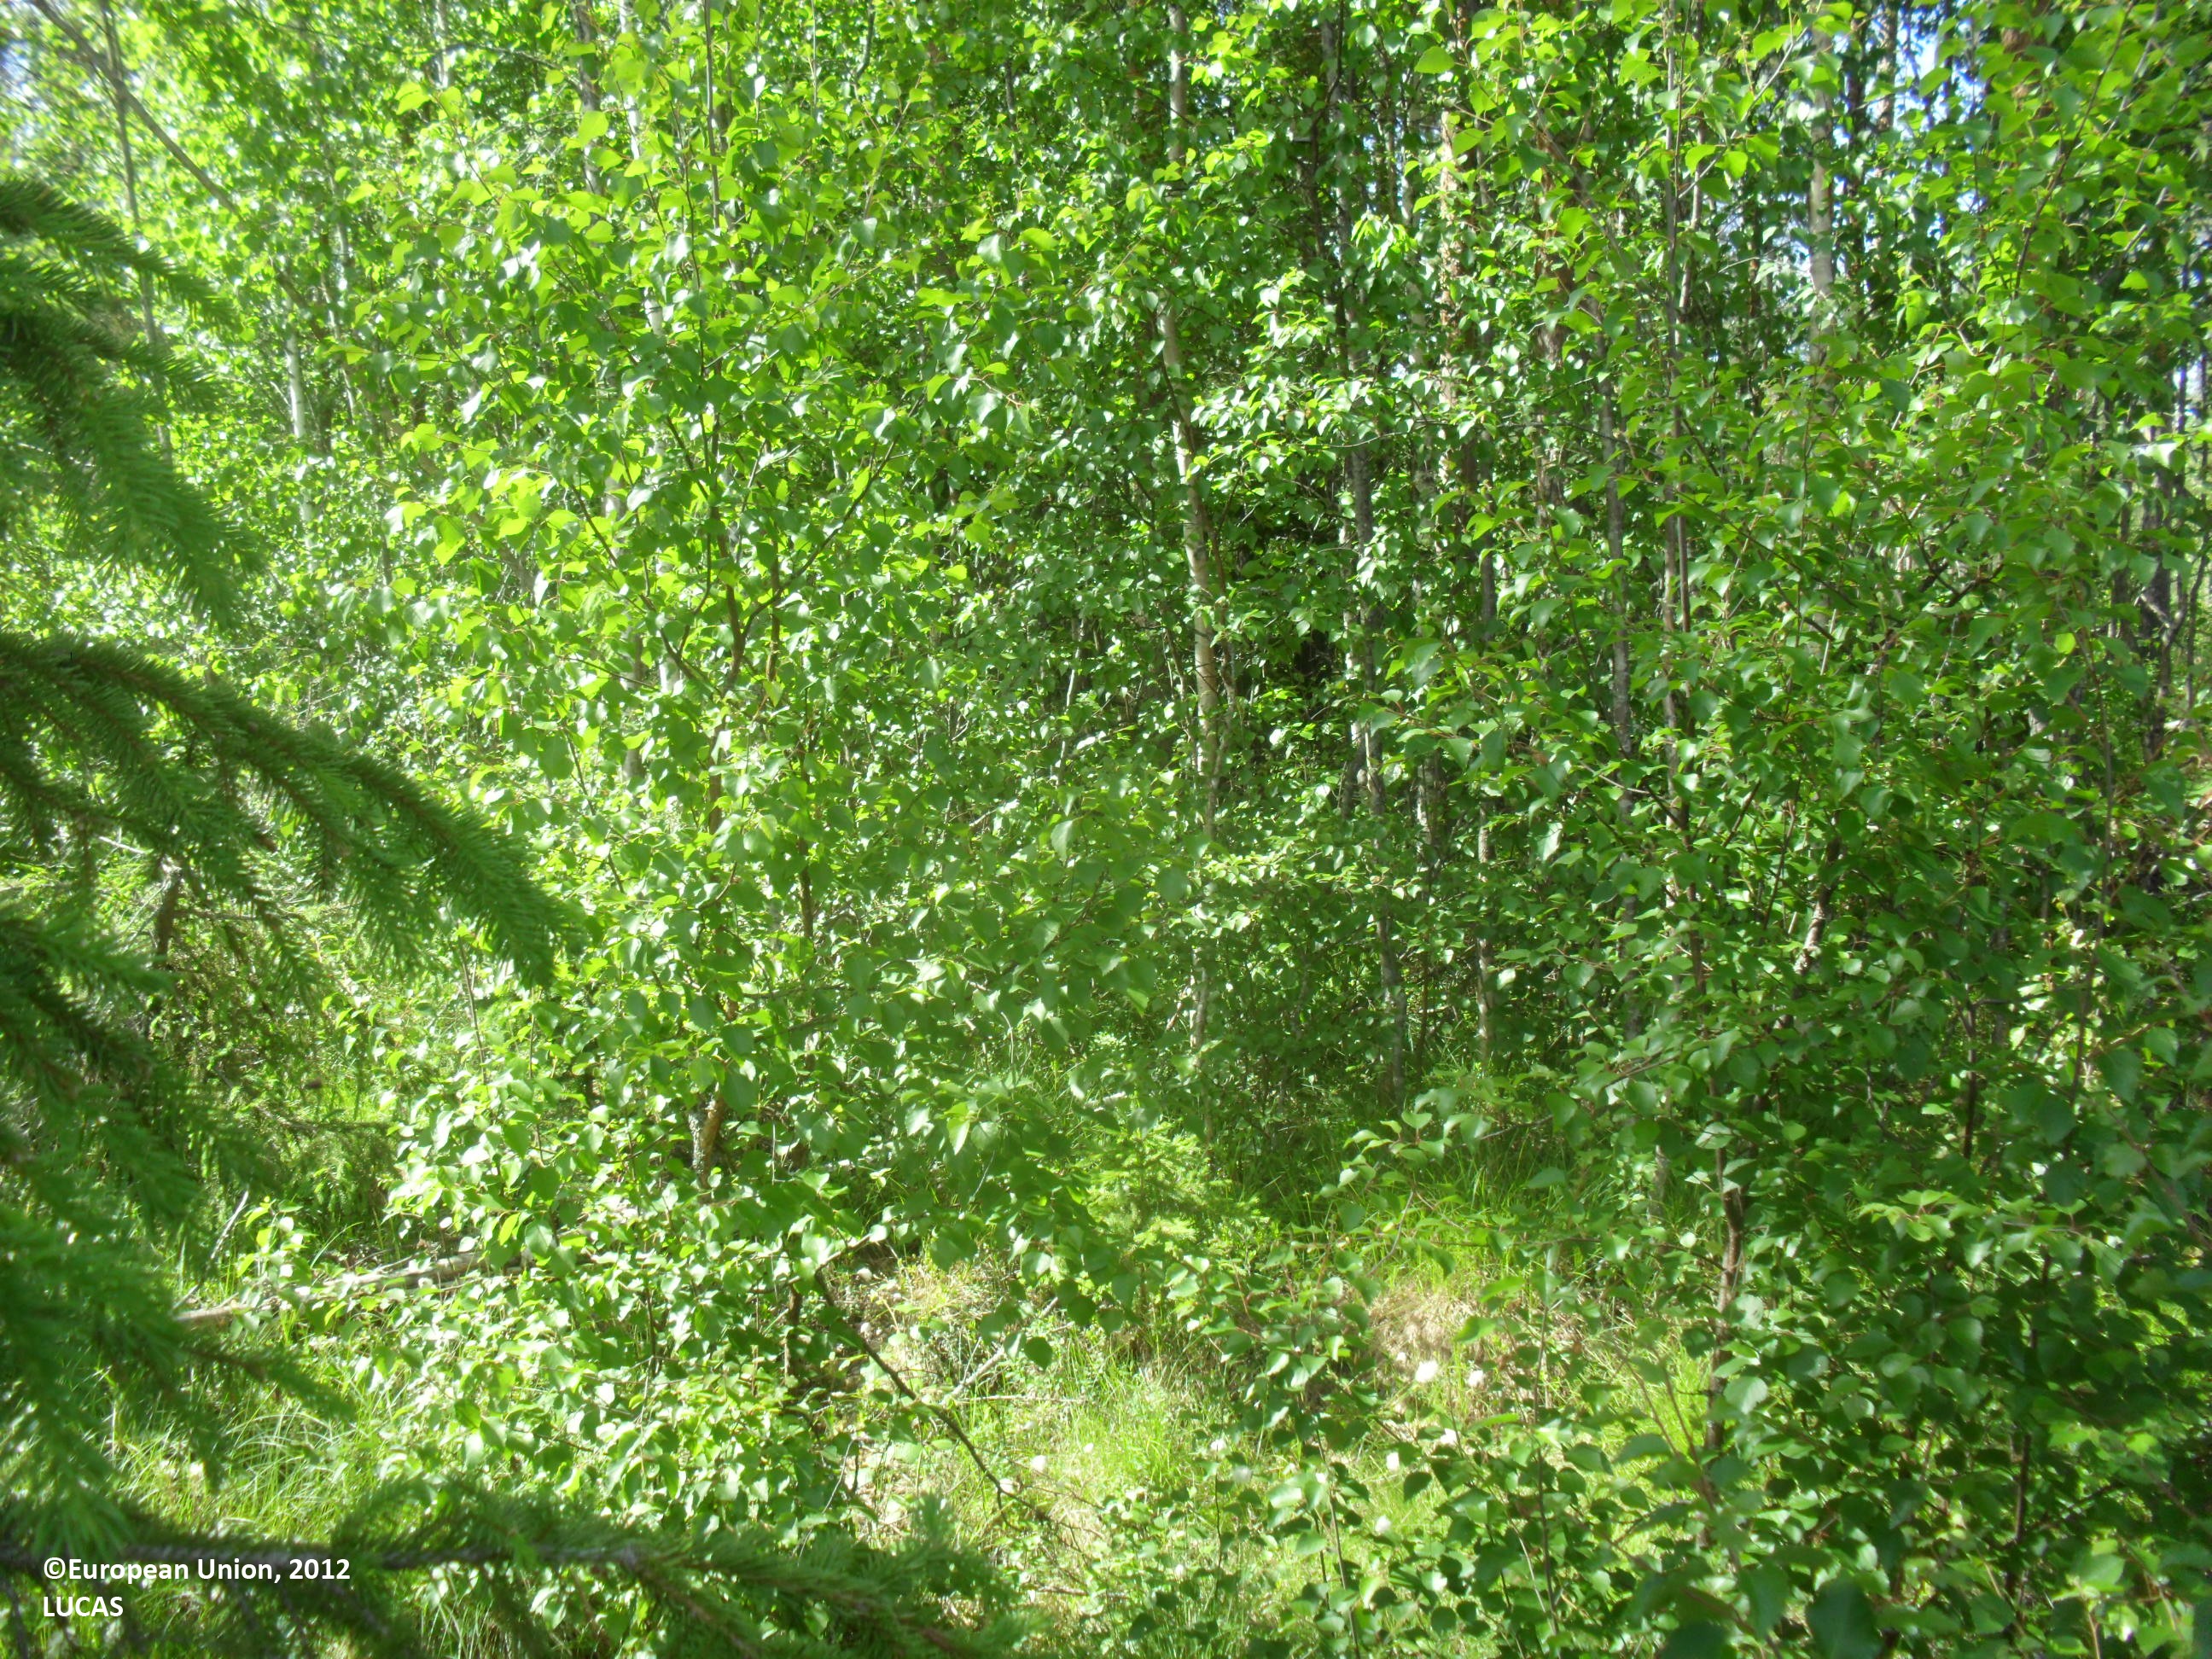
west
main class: Woodland
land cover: Other mixed woodland
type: boreal forest
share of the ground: 25 - 50 %
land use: Forestry
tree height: > 5 m
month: June
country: FI
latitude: 63.3595
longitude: 23.0698
